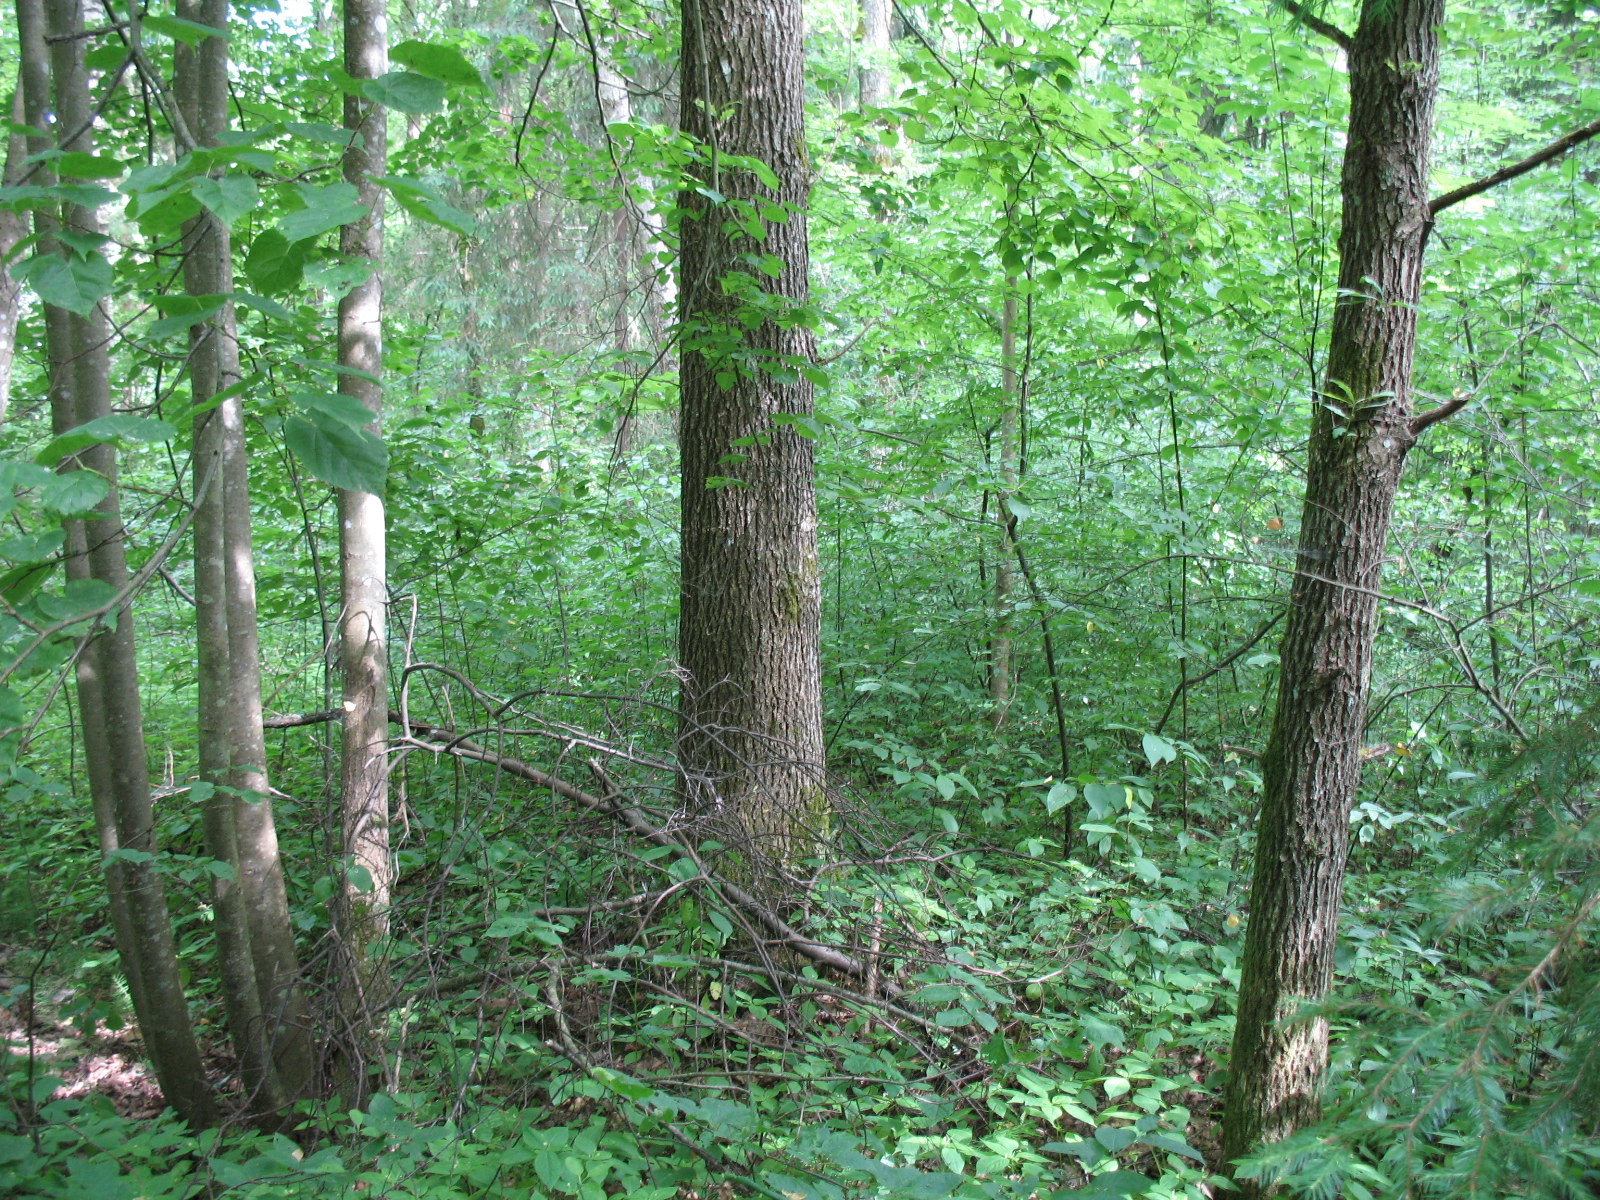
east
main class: Woodland
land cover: Broadleaved woodland
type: non-riverine alder, birch or aspen forest
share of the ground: > 75 %
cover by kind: broadleaved forest trees 80 %, coniferous forest trees 10 %, herbaceous plants 10 %
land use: Forestry
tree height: > 5 m
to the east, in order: Broadleaved woodland; Pine dominated mixed woodland; Spontaneously vegetated surfaces; Fences; Grassland without tree/shrub cover; Artificial constructions in urban areas; Grassland without tree/shrub cover
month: June
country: LV
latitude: 56.7002
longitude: 23.7819
